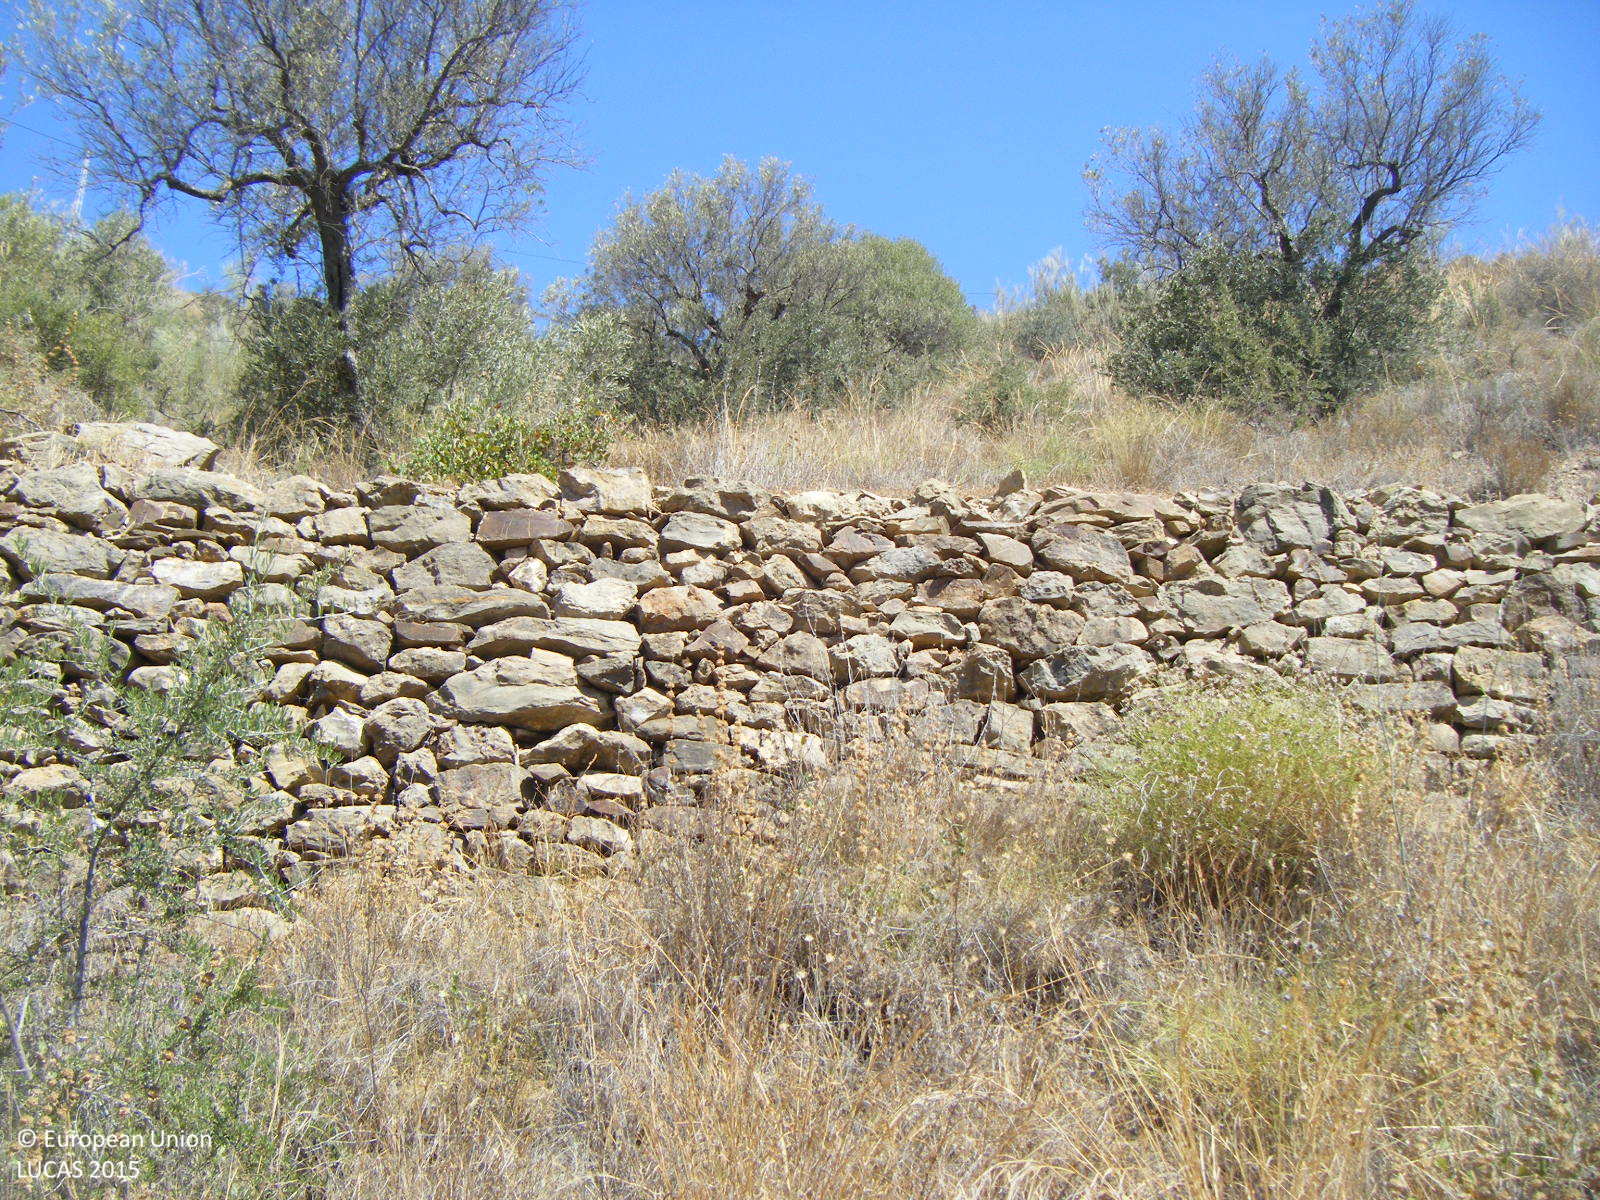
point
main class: Cropland
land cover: Olive groves
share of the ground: 10 - 25 %
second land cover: Spontaneously vegetated surfaces
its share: > 75 %
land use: Abandoned areas
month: July
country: ES
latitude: 36.7326
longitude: -4.3110
